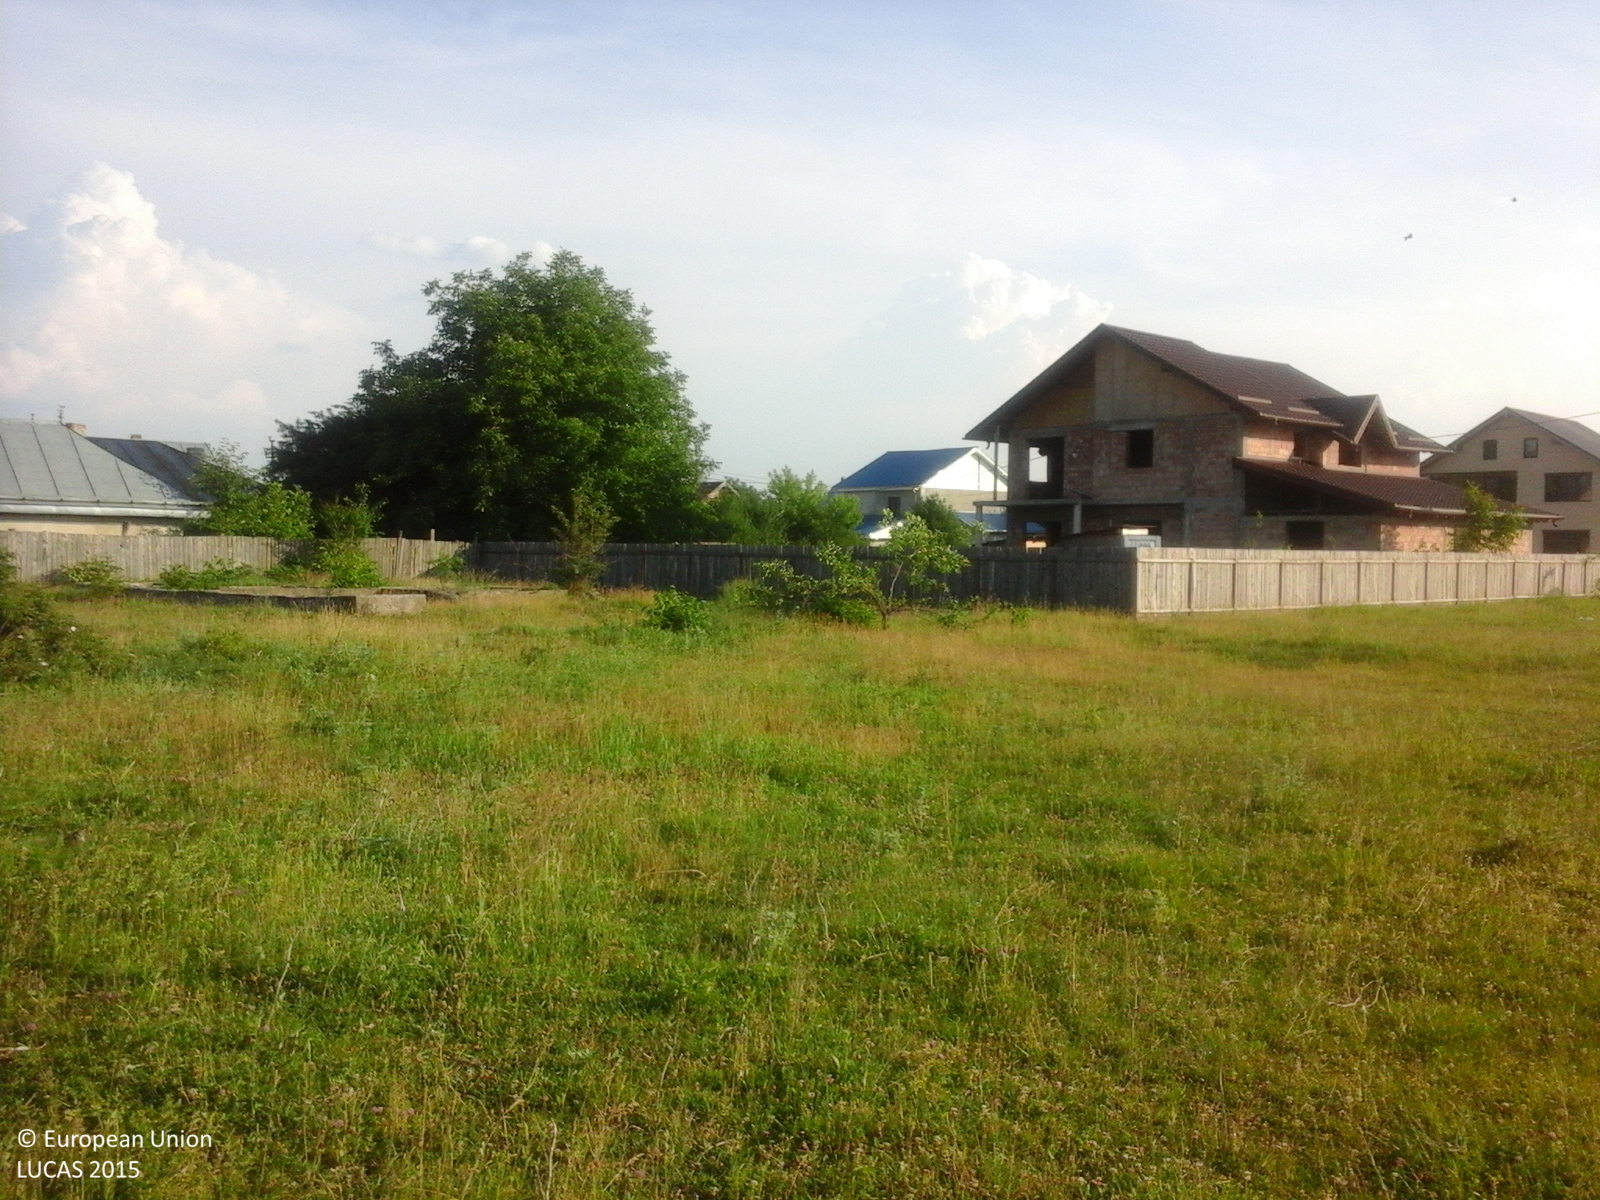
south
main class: Grassland
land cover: Grassland without tree/shrub cover
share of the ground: > 75 %
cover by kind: herbaceous plants 100 %
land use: Agriculture (excluding fallow land and kitchen gardens)
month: June
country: RO
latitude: 46.5865
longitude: 26.9437
